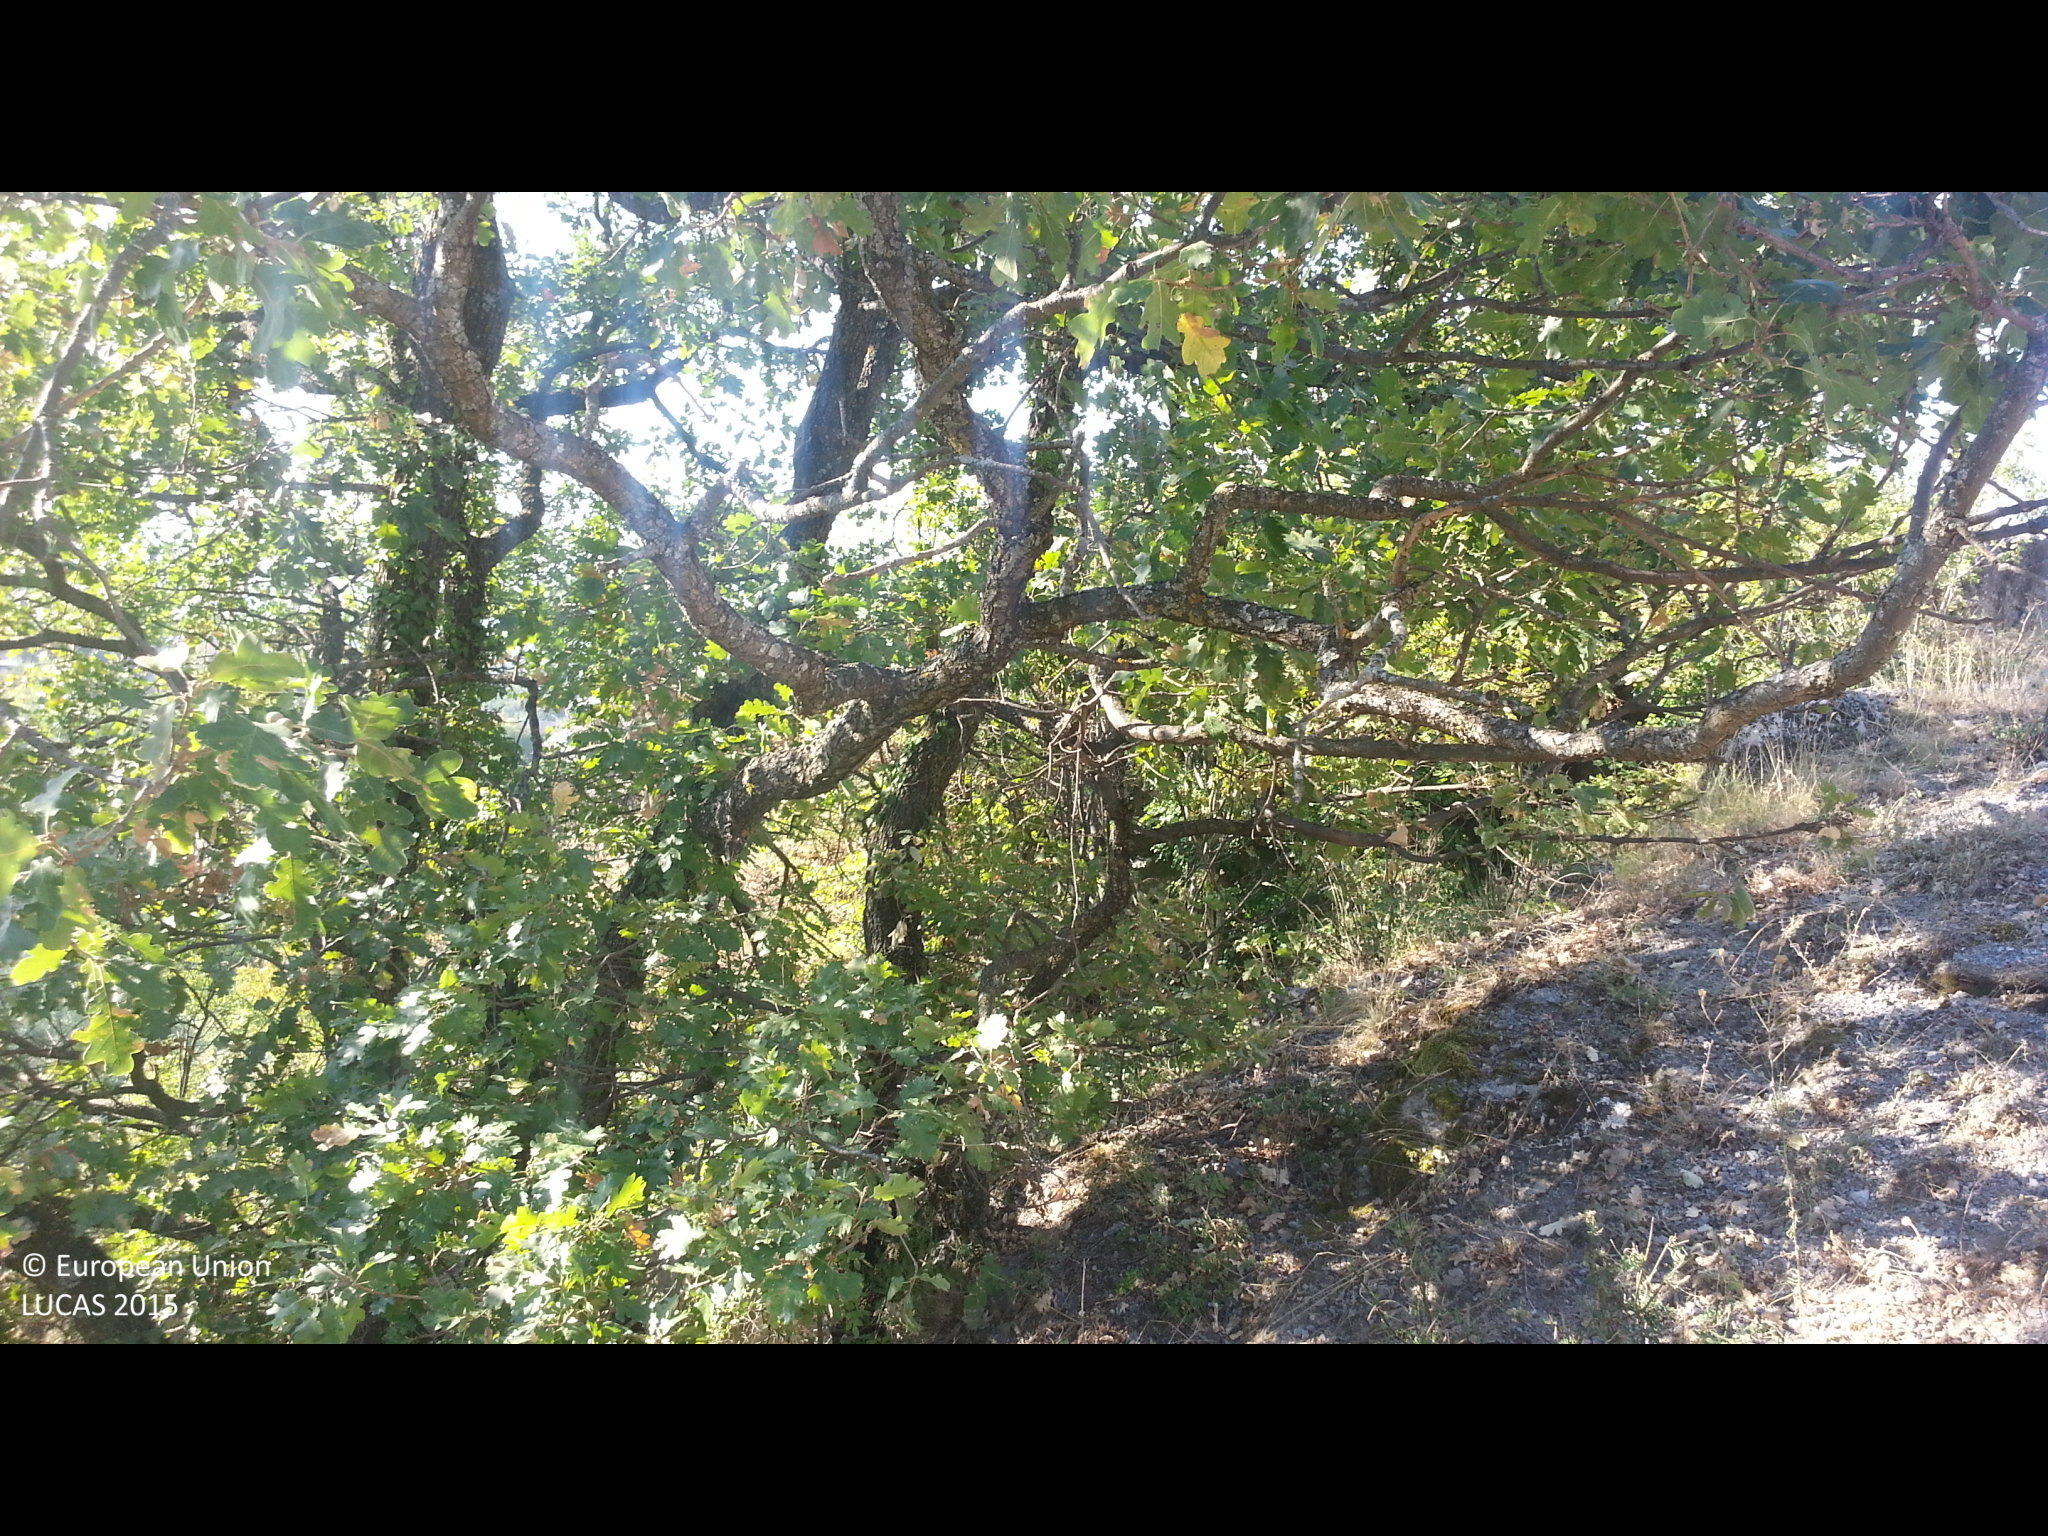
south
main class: Shrubland
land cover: Shrubland with sparse tree cover
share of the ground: 50 - 75 %
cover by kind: shrubs 55 %, consolidated bare surface 40 %, broadleaved forest trees 5 %
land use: Semi-natural and natural areas not in use
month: September
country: BG
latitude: 42.3364
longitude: 22.9022
